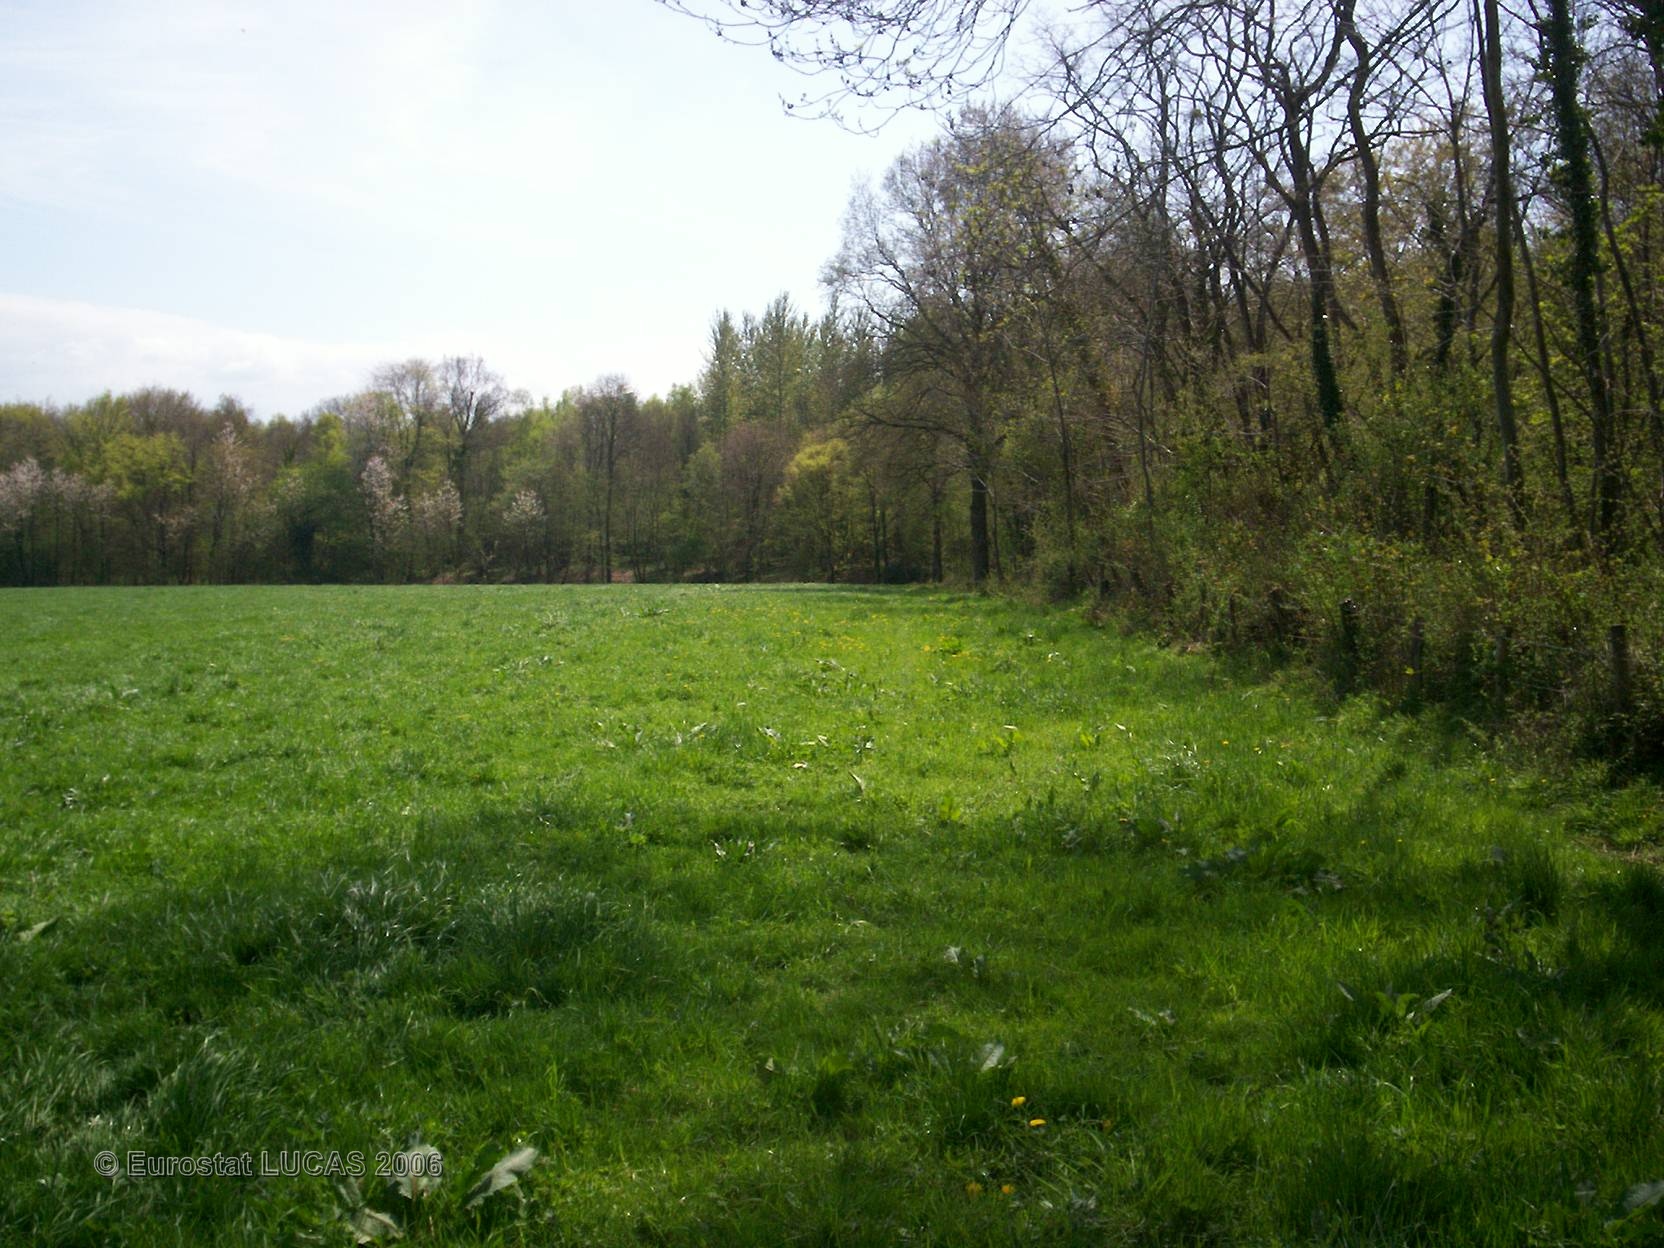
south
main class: Grassland
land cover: Grassland without tree/shrub cover
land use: Agriculture (excluding fallow land and kitchen gardens)
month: April
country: FR
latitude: 49.2174
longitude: -0.2063
